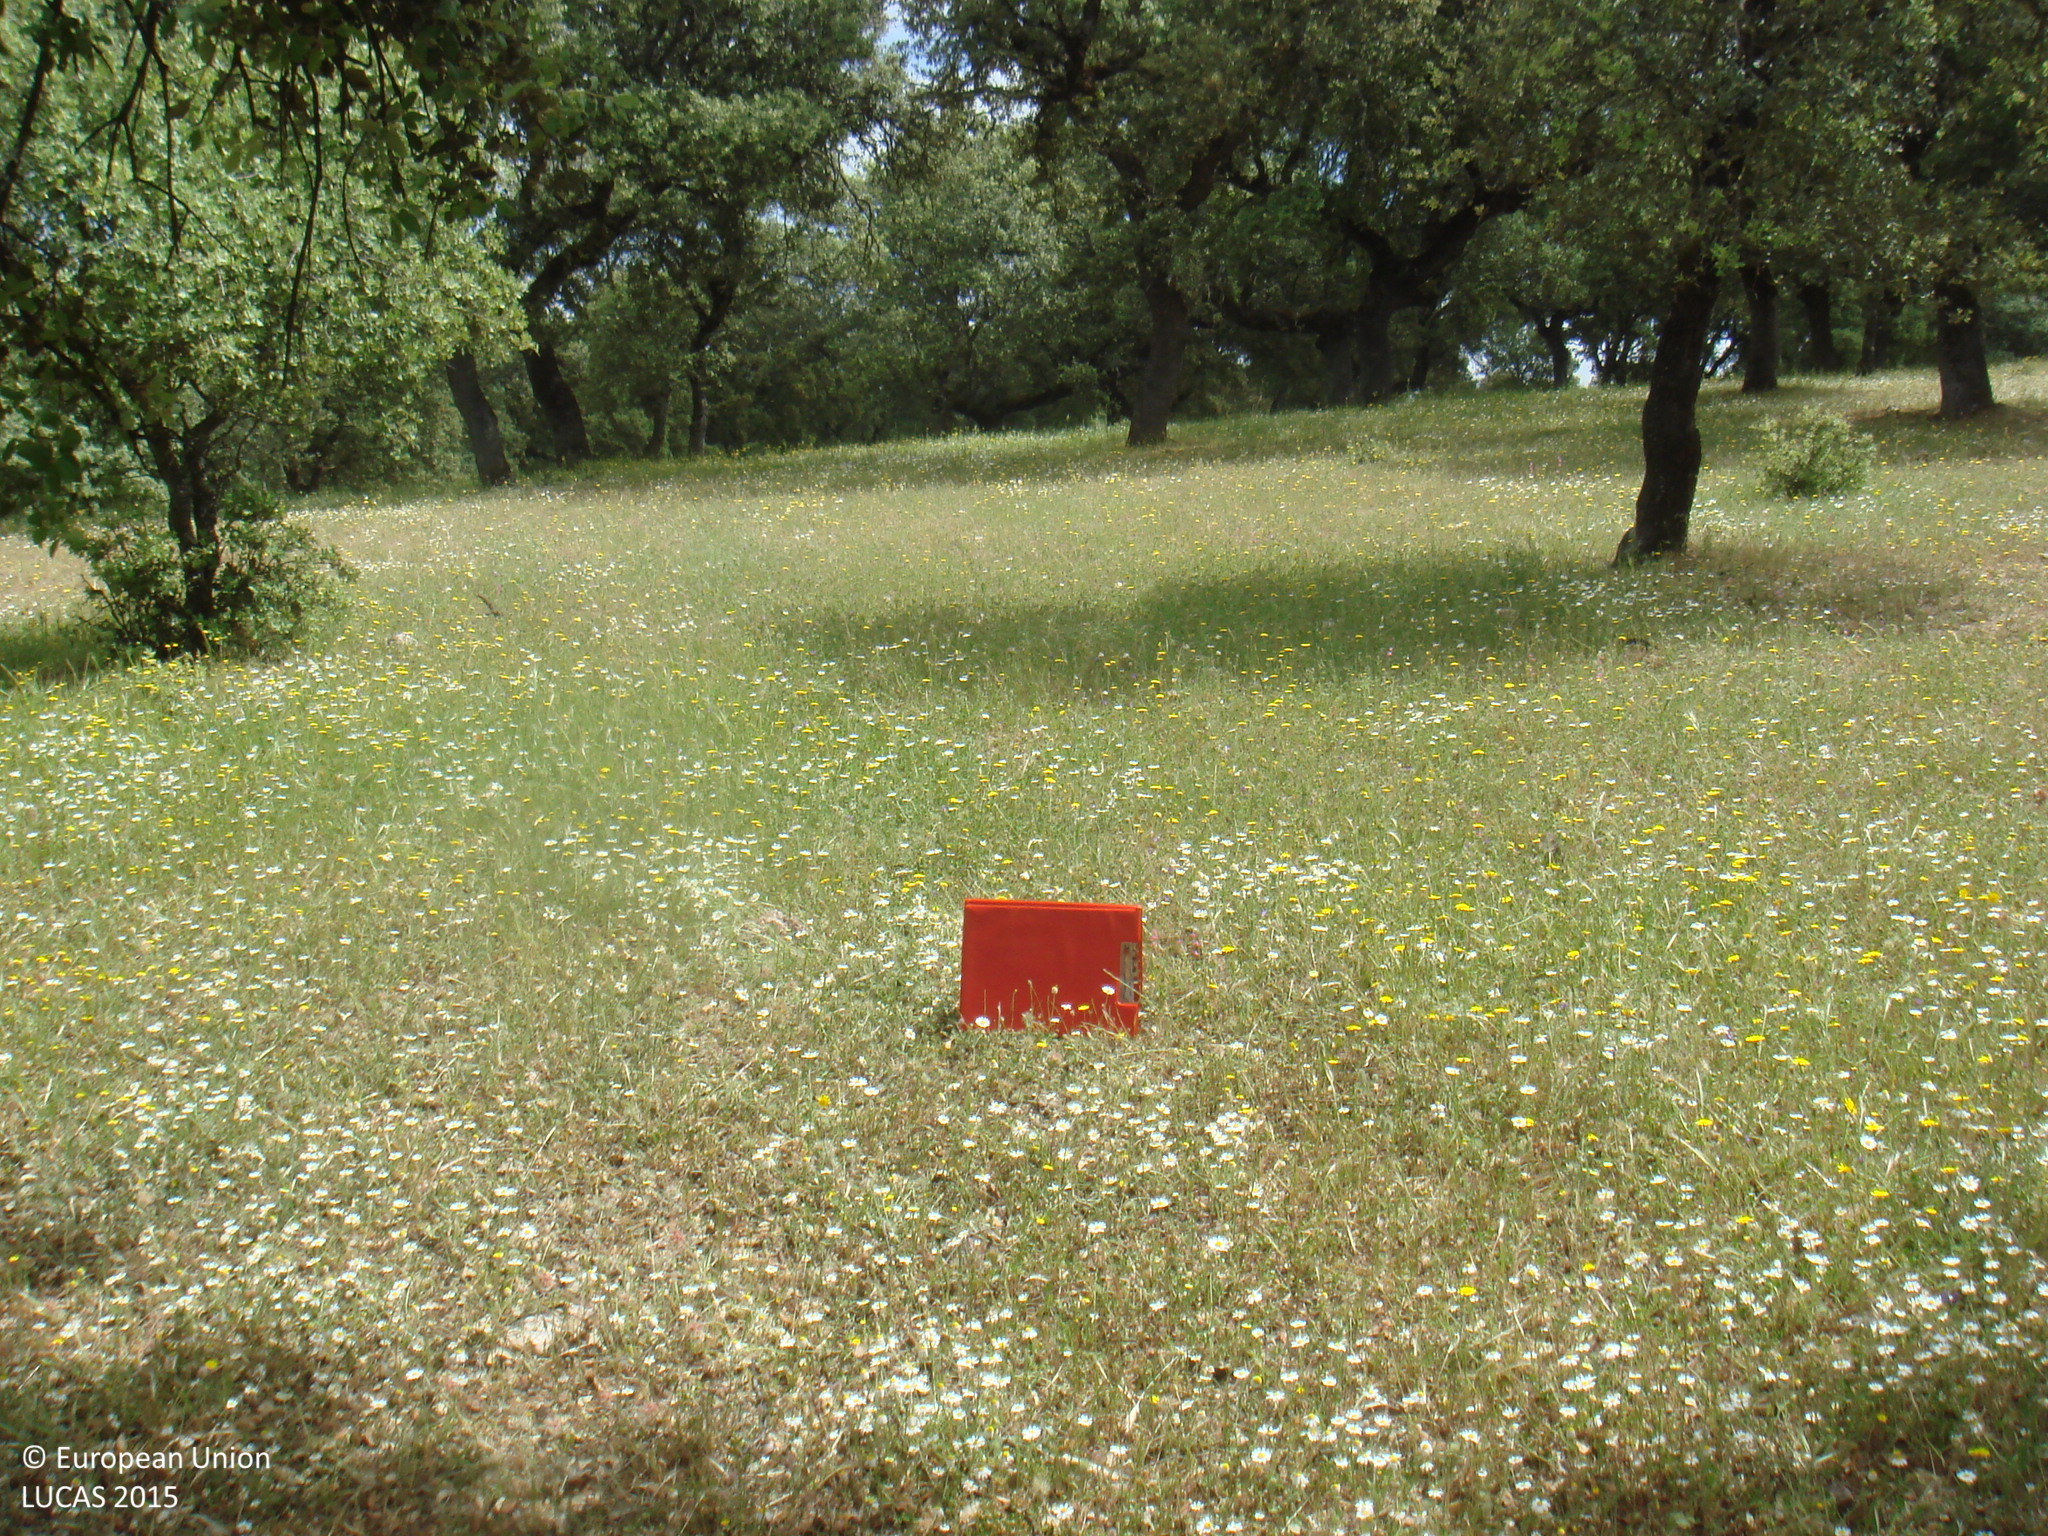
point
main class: Woodland
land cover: Broadleaved woodland
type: broadleaved evergreen forest
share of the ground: 50 - 75 %
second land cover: Spontaneously vegetated surfaces
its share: > 75 %
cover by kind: broadleaved forest trees 60 %, herbaceous plants 40 %
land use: Forestry
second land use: Agriculture (excluding fallow land and kitchen gardens)
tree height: > 5 m
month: May
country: ES
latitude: 38.3187
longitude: -4.3935
